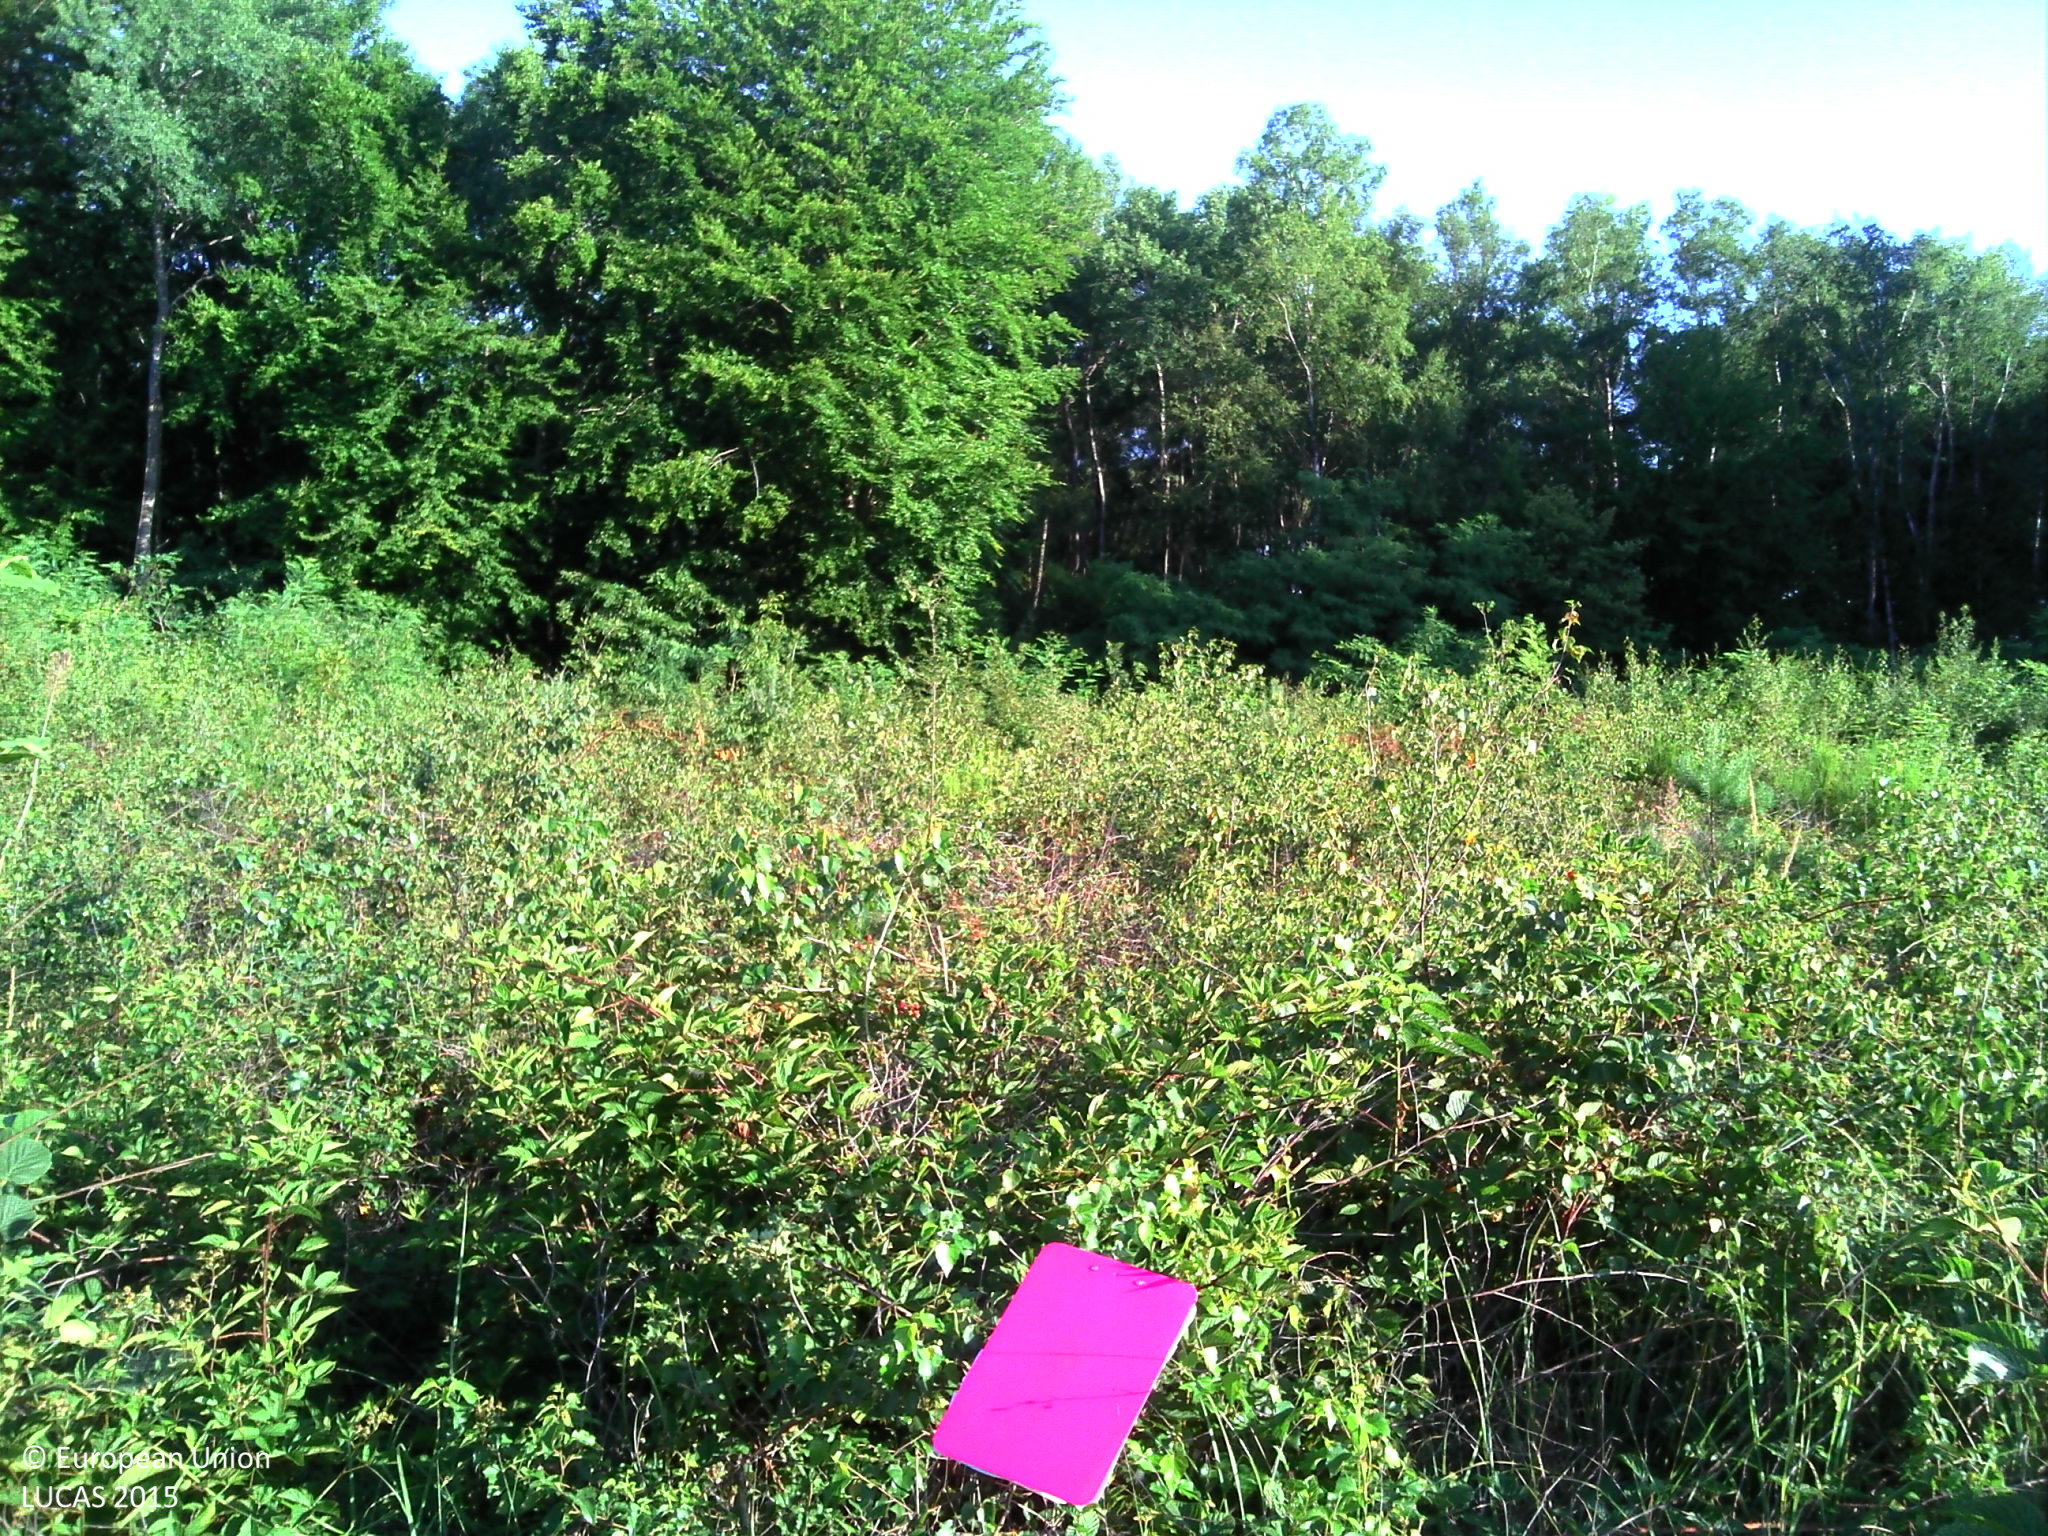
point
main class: Shrubland
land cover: Shrubland without tree cover
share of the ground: > 75 %
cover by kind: shrubs 65 %, herbaceous plants 35 %
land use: Semi-natural and natural areas not in use
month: July
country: FR
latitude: 49.2741
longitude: 2.5803
